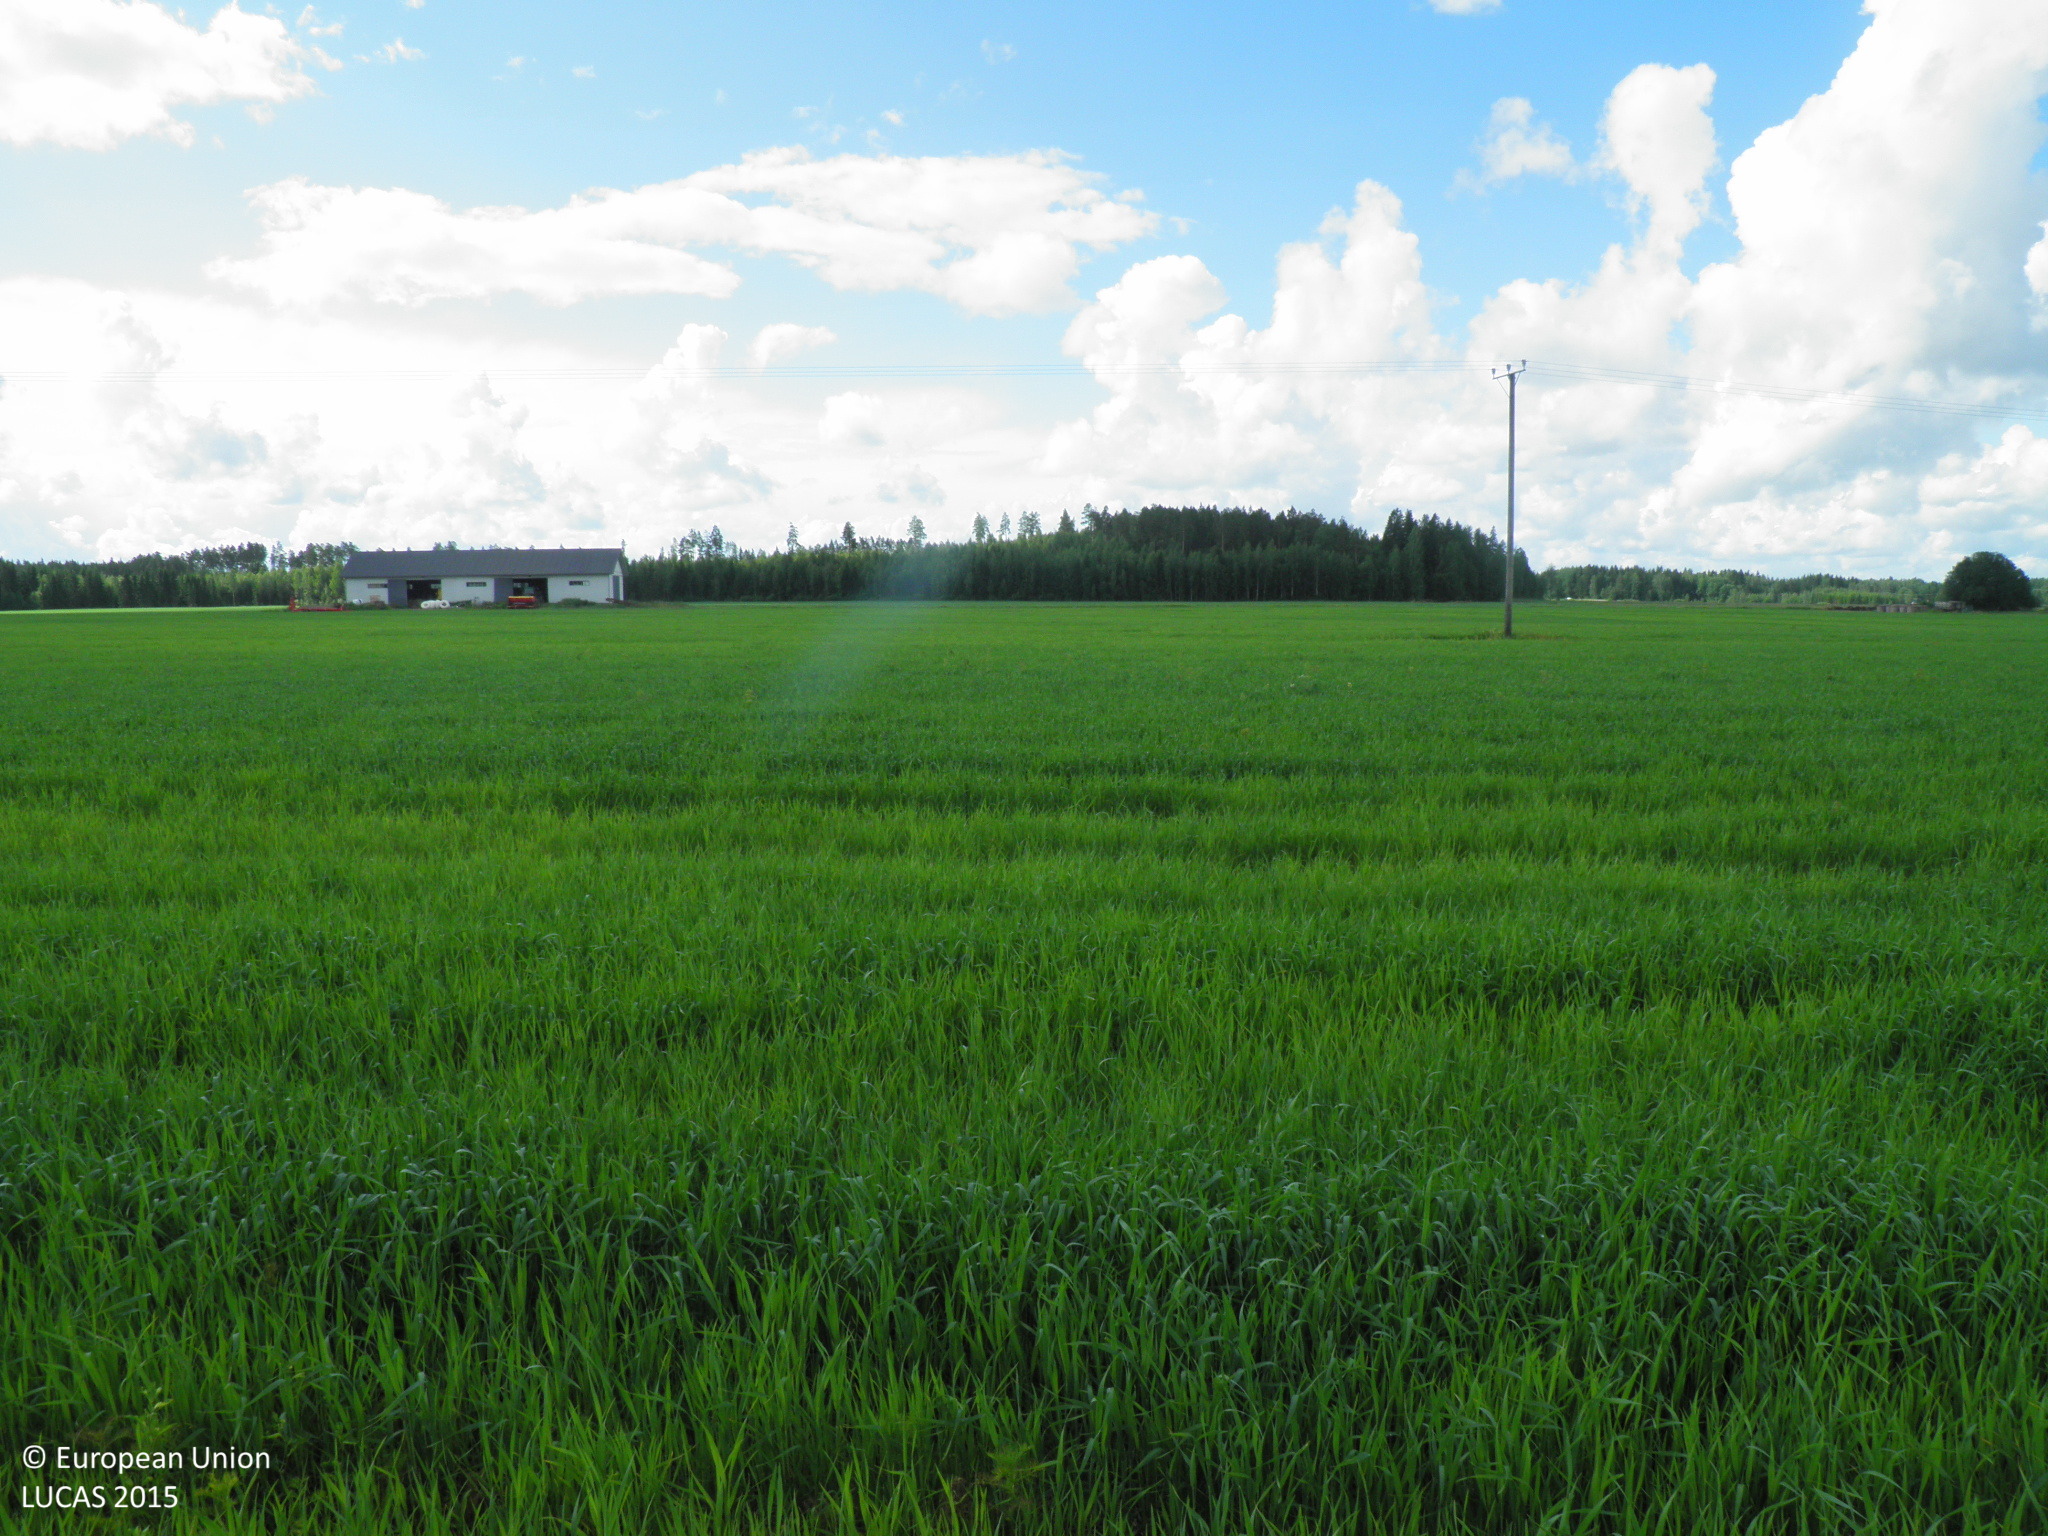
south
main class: Cropland
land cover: Common wheat
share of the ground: > 75 %
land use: Agriculture (excluding fallow land and kitchen gardens)
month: July
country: FI
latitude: 60.8289
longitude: 22.8934
